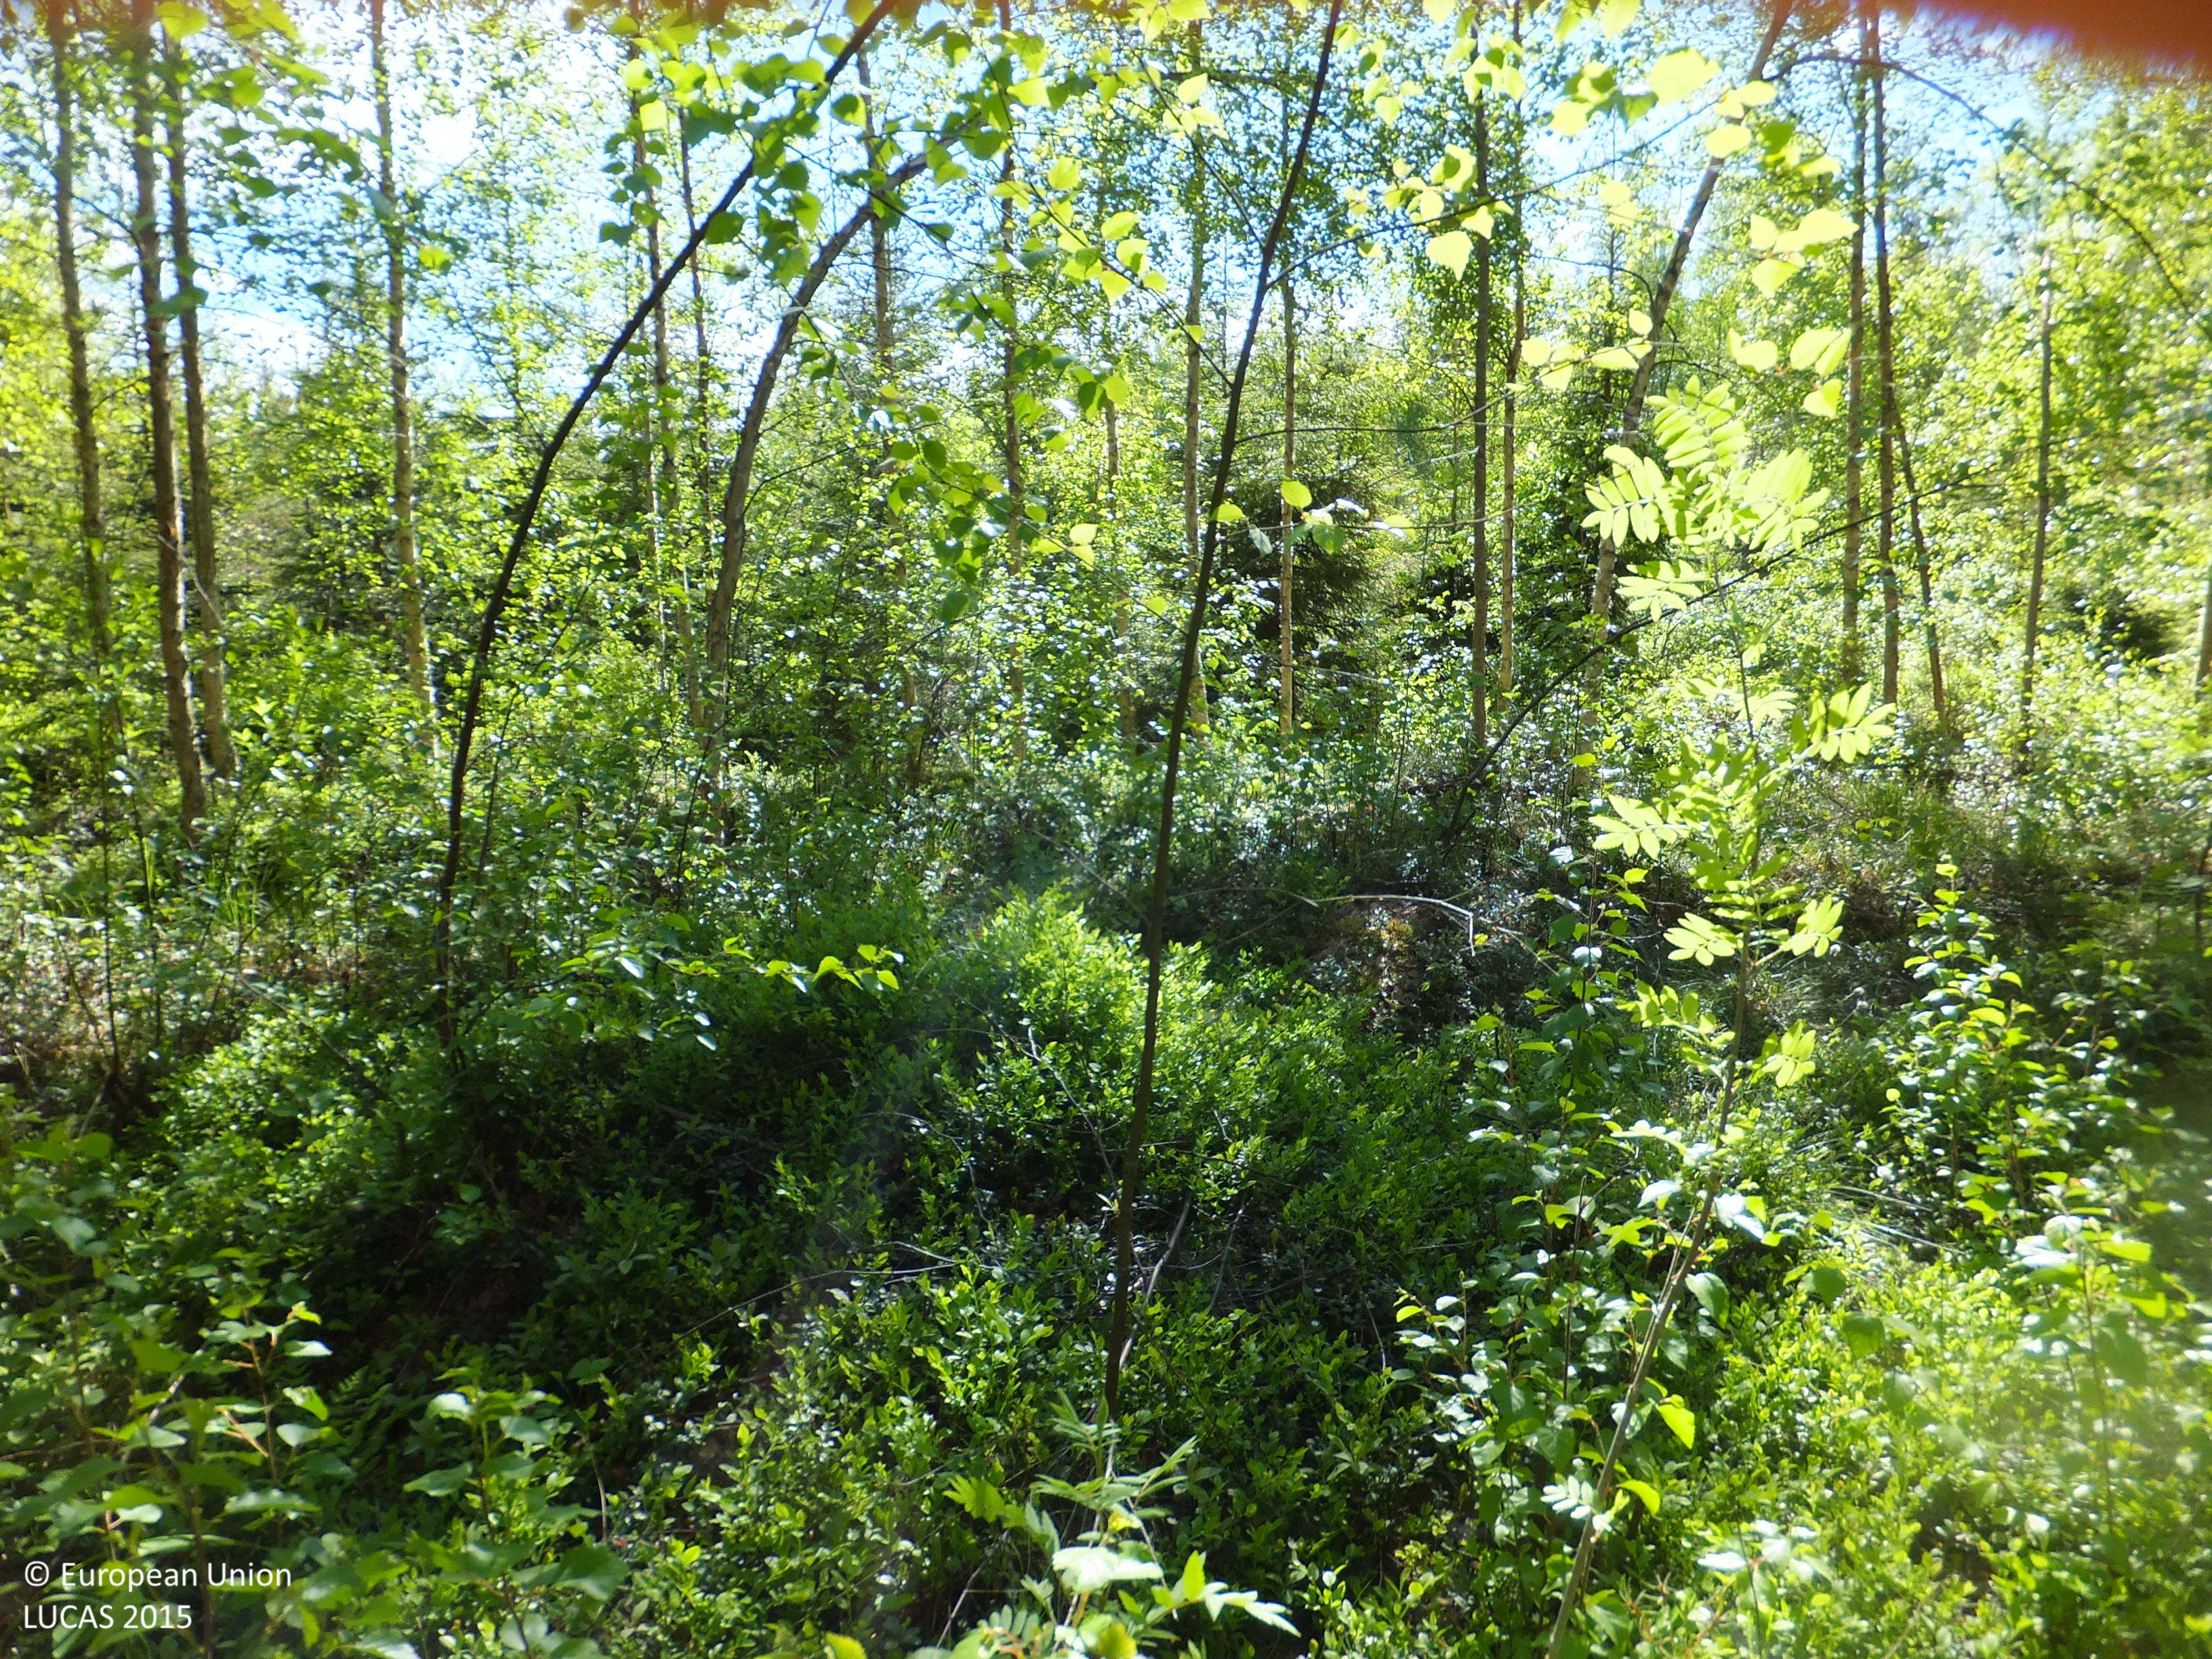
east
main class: Woodland
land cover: Other mixed woodland
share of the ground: > 75 %
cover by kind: broadleaved forest trees 60 %, coniferous forest trees 30 %, shrubs 10 %
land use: Forestry
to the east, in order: Other mixed woodland; Broadleaved woodland; Ditches and canals; Other mixed woodland; Shrubland without tree cover; Ditches and canals; Spruce dominated mixed woodland; Ditches and canals; Spruce dominated mixed woodland; Ditches and canals; Spruce dominated mixed woodland; Ditches and canals; Spruce dominated mixed woodland; Dry stone walls; Spruce dominated mixed woodland; Ditches and canals; Spruce dominated mixed woodland; Tracks; Spruce dominated mixed woodland; Ditches and canals; Lines of trees; Grass margins; Paved roads, cycling and walking lanes; Lines of trees; Rivers and streams; Grass margins; Grassland without tree/shrub cover; Ditches and canals; Grassland without tree/shrub cover
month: June
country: FI
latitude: 63.4114
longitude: 22.8900
